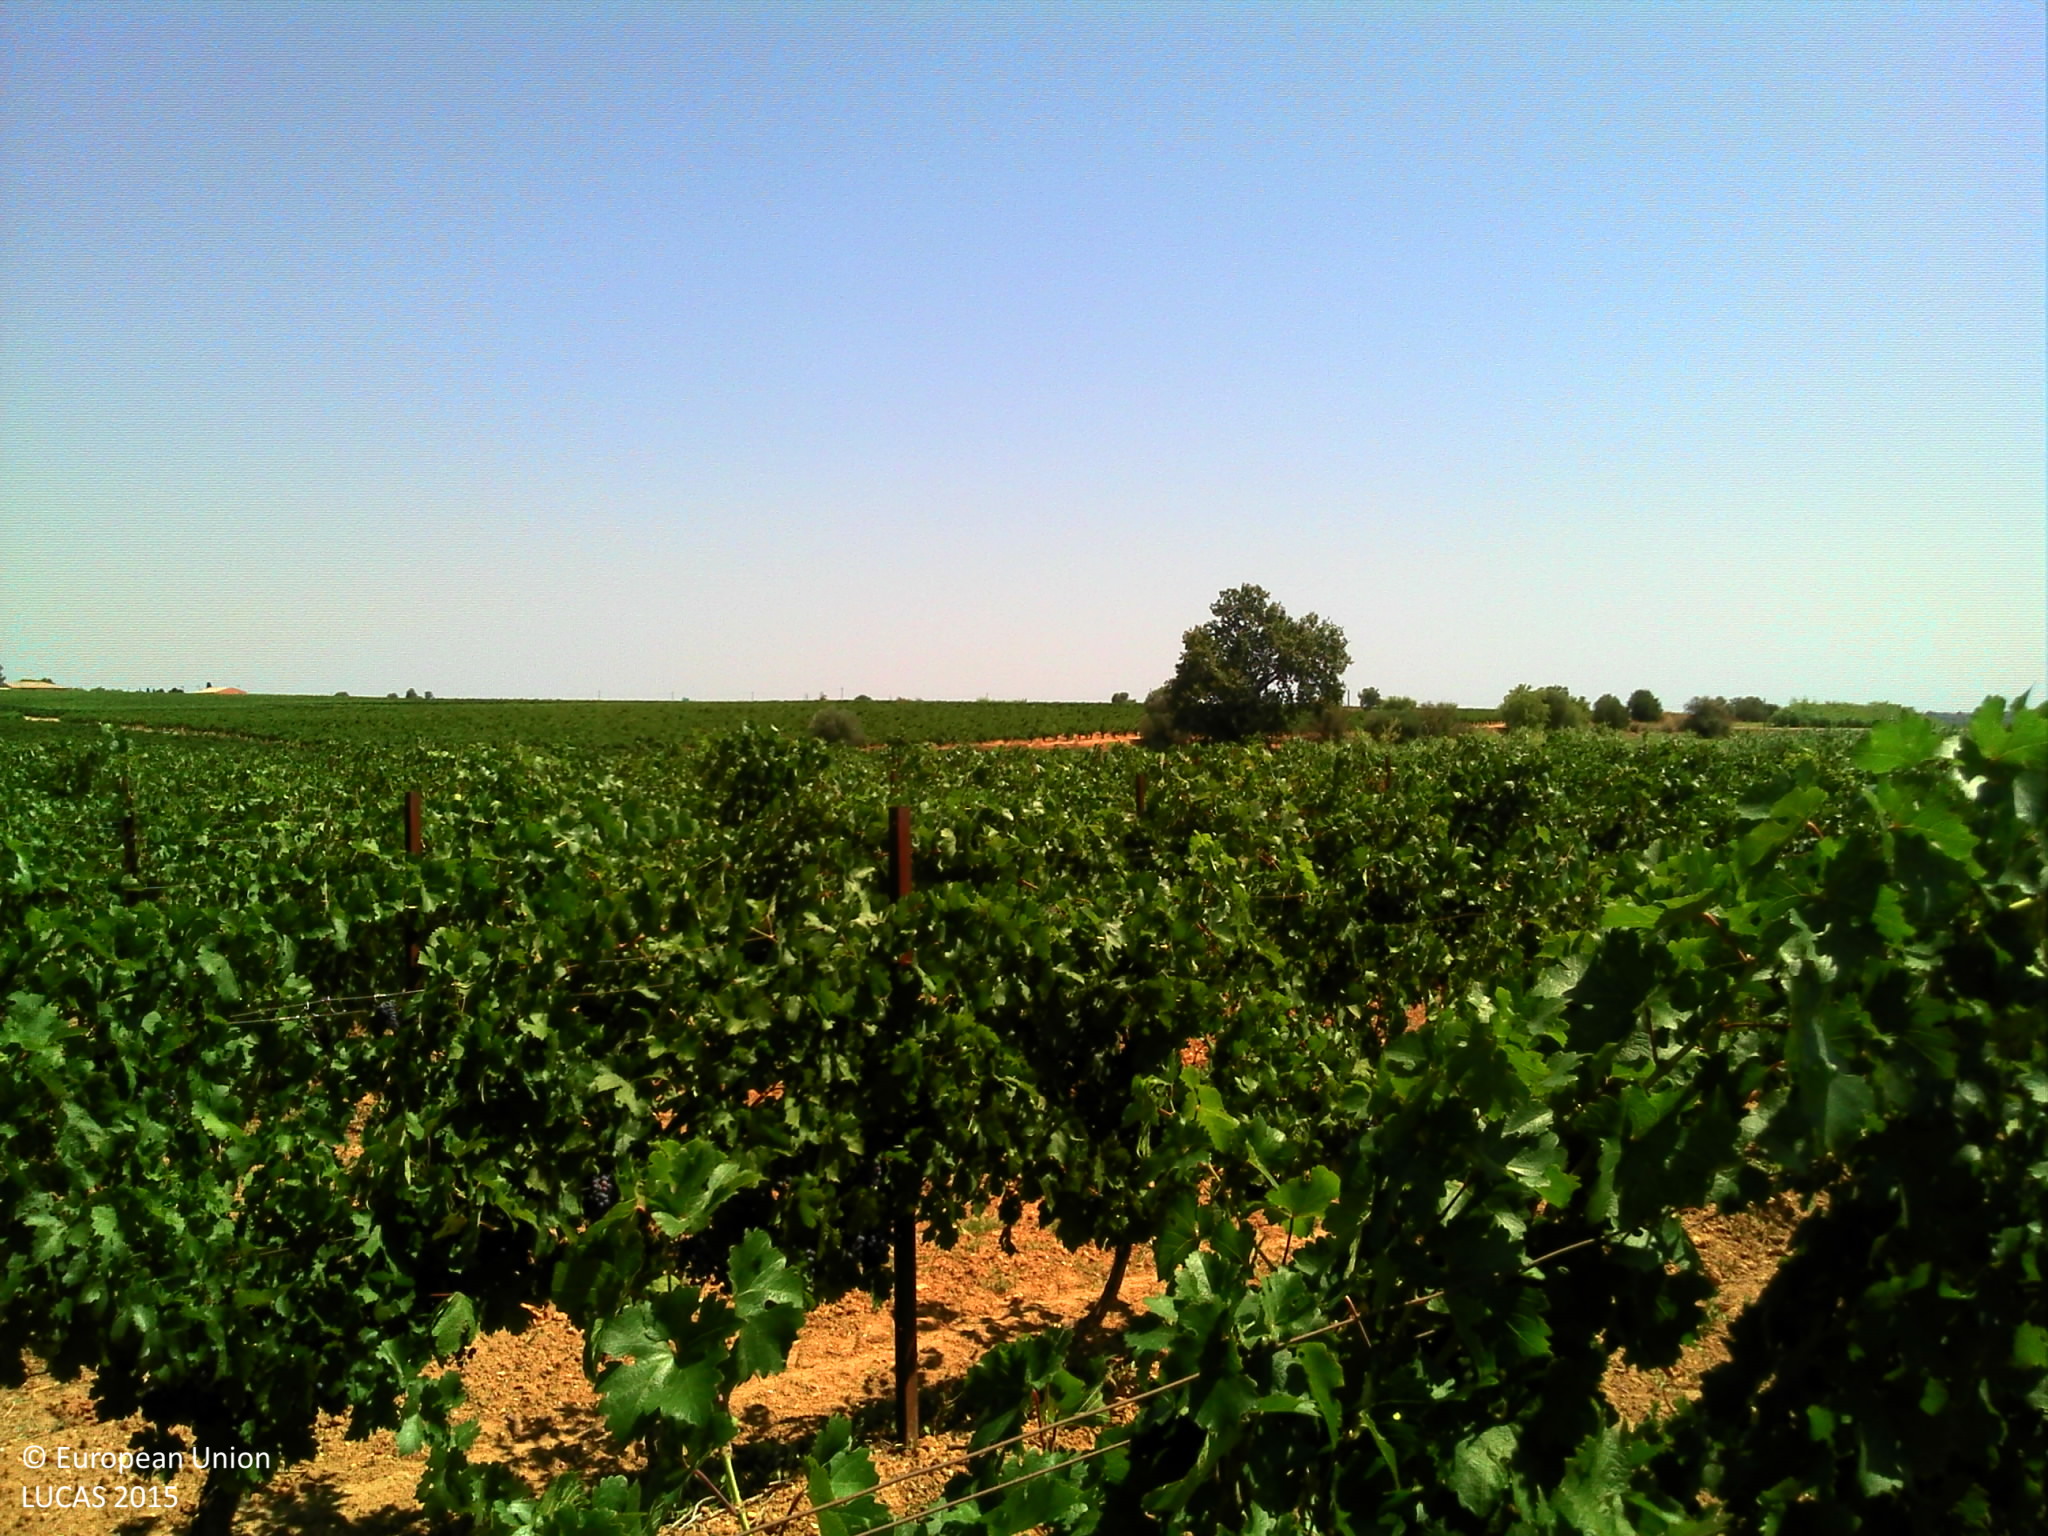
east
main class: Cropland
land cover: Vineyards
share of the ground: 10 - 25 %
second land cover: Other bare soil
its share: > 75 %
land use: Agriculture (excluding fallow land and kitchen gardens)
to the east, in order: Vineyards; Other bare soil; Grass margins; Tracks; Vineyards; Tracks; Broadleaved woodland; Vineyards; Tracks; Grass margins; Ditches and canals; Single bushes/trees; Grass margins; Vineyards
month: August
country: FR
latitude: 43.4134
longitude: 3.3528
